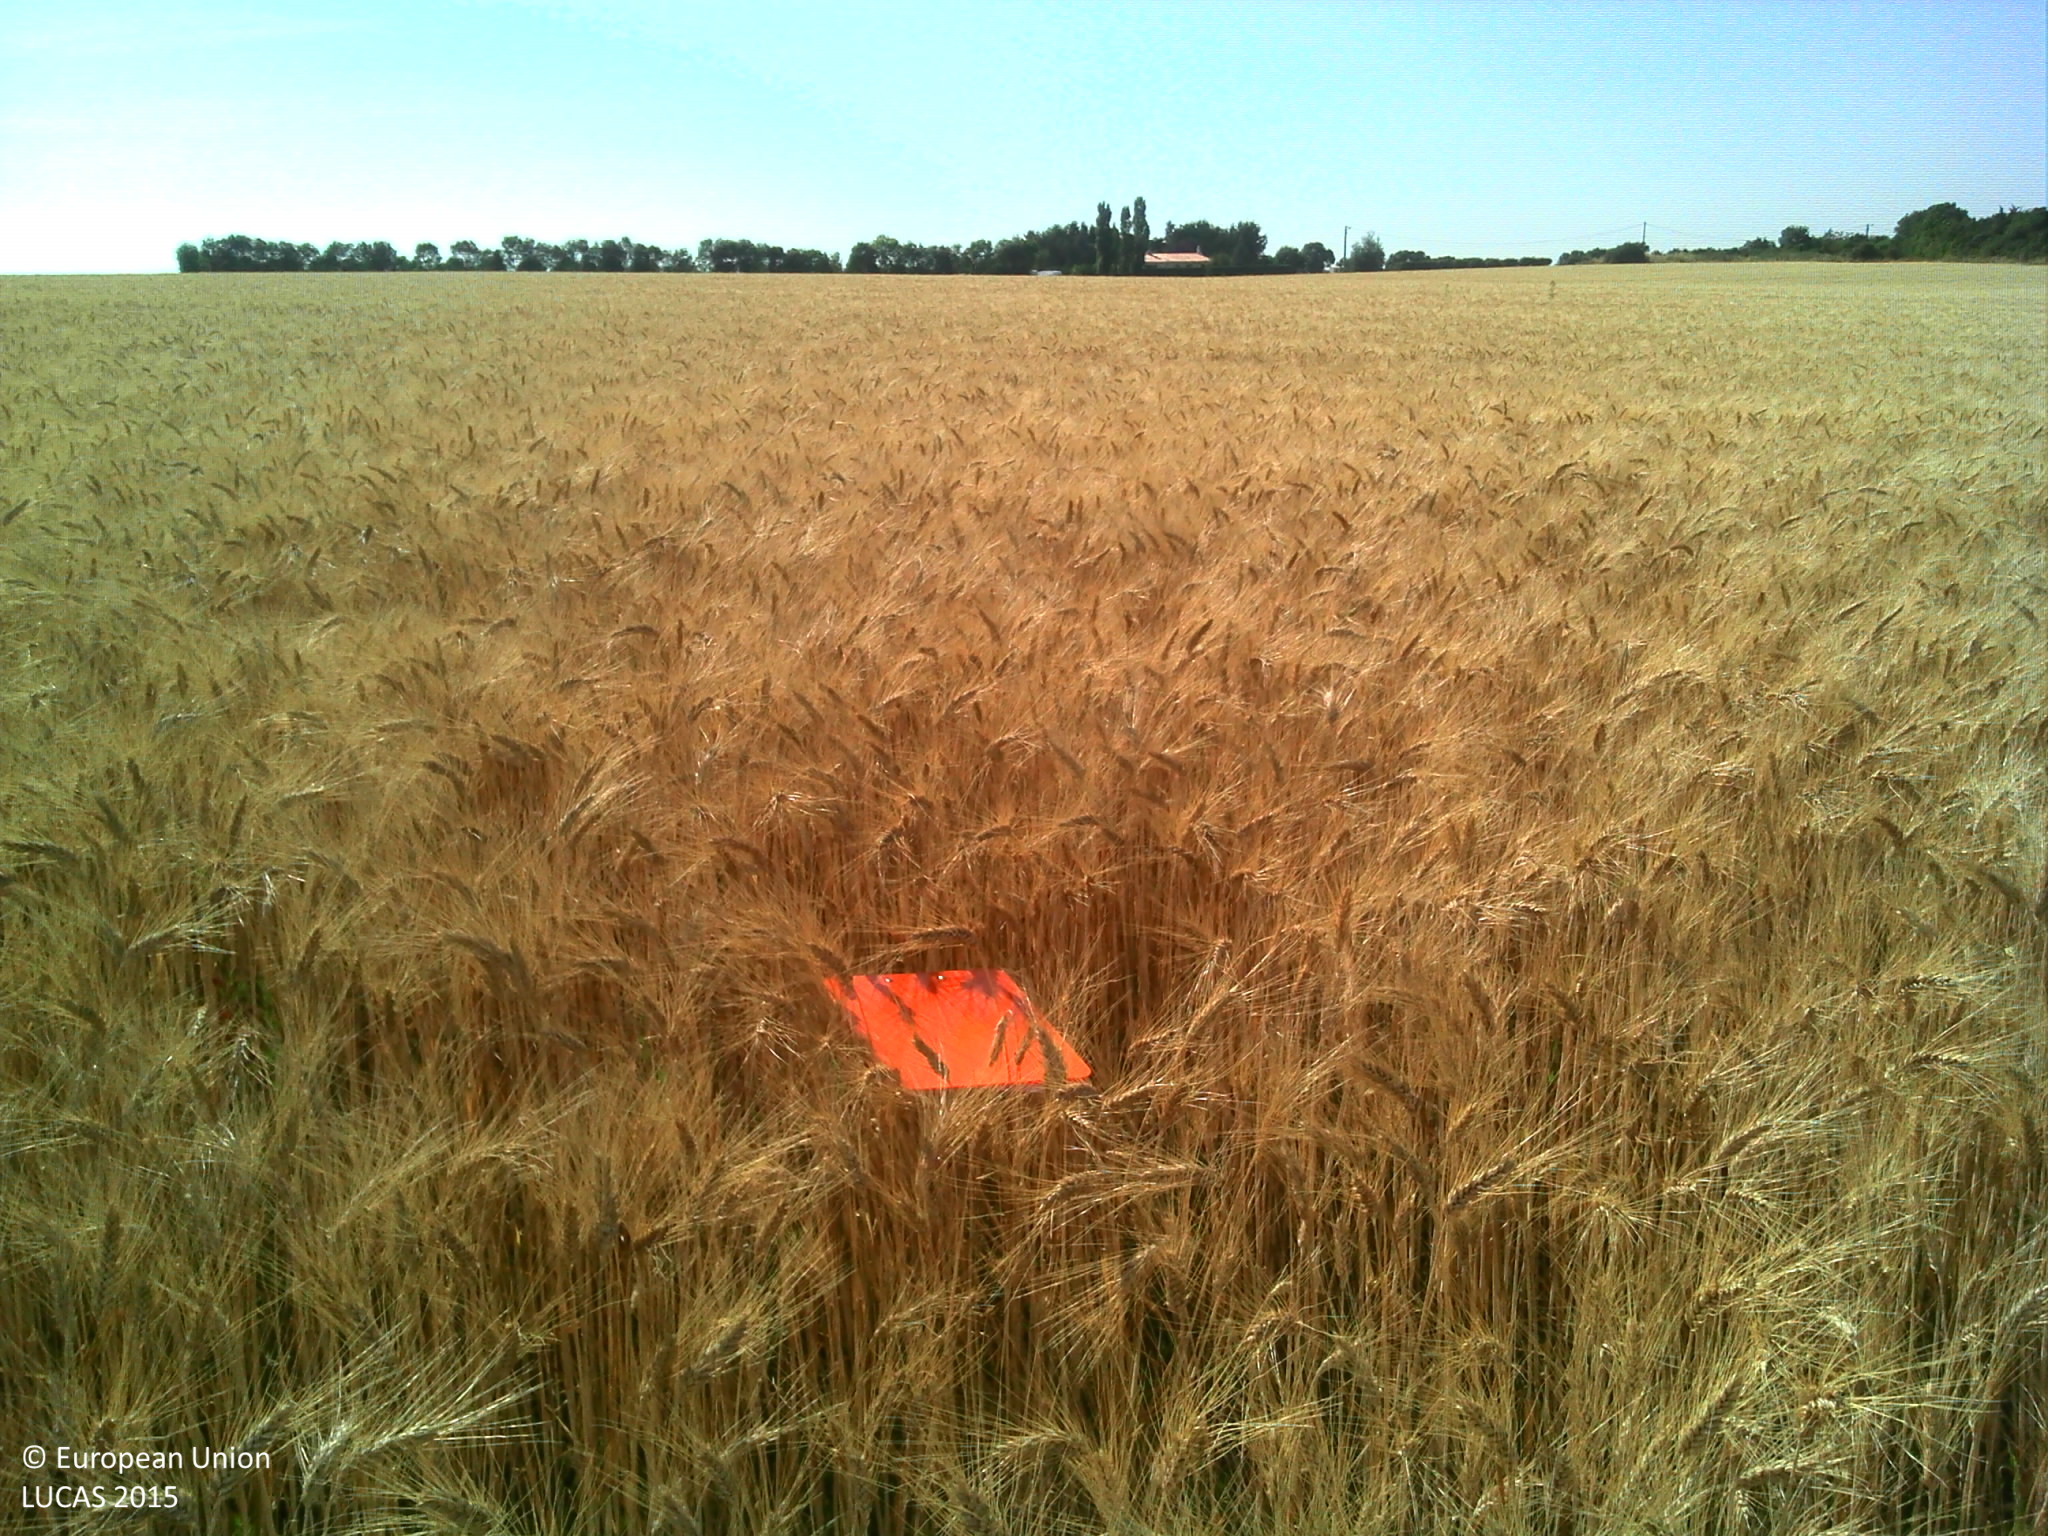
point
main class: Cropland
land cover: Common wheat
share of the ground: > 75 %
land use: Agriculture (excluding fallow land and kitchen gardens)
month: July
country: FR
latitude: 46.4347
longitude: -1.5298
